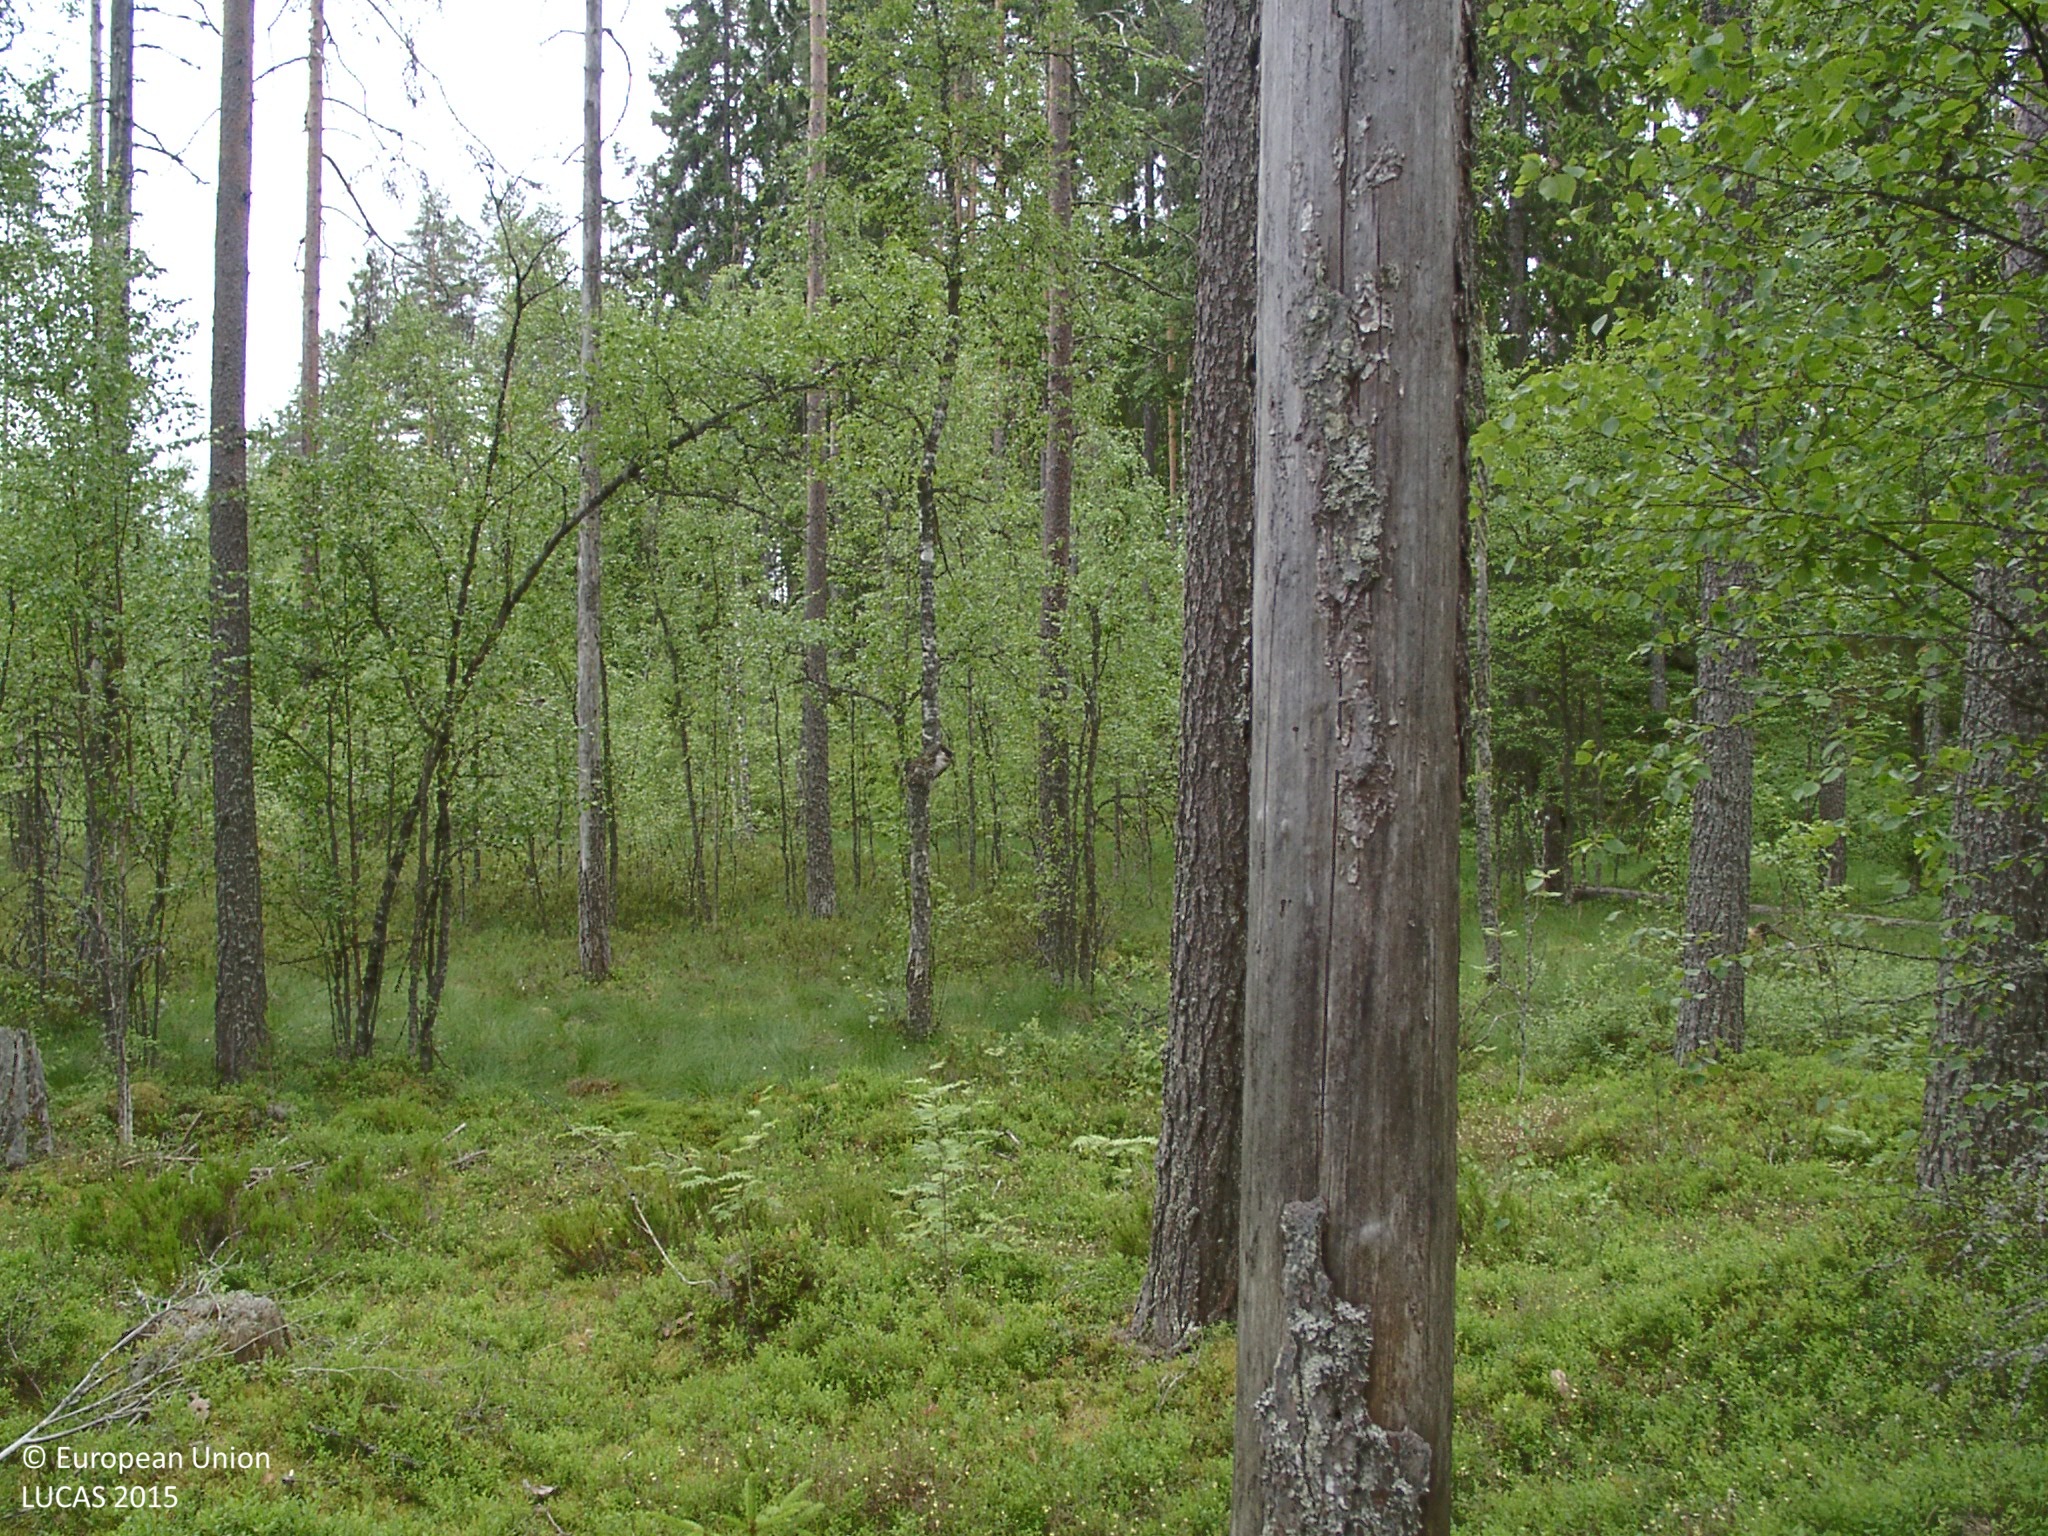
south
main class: Woodland
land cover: Other mixed woodland
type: boreal forest
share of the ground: 50 - 75 %
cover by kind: shrubs 40 %, coniferous forest trees 35 %, broadleaved forest trees 15 %, lichens and mosses 10 %
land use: Forestry
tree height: > 5 m
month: July
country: FI
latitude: 61.7027
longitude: 25.2217
